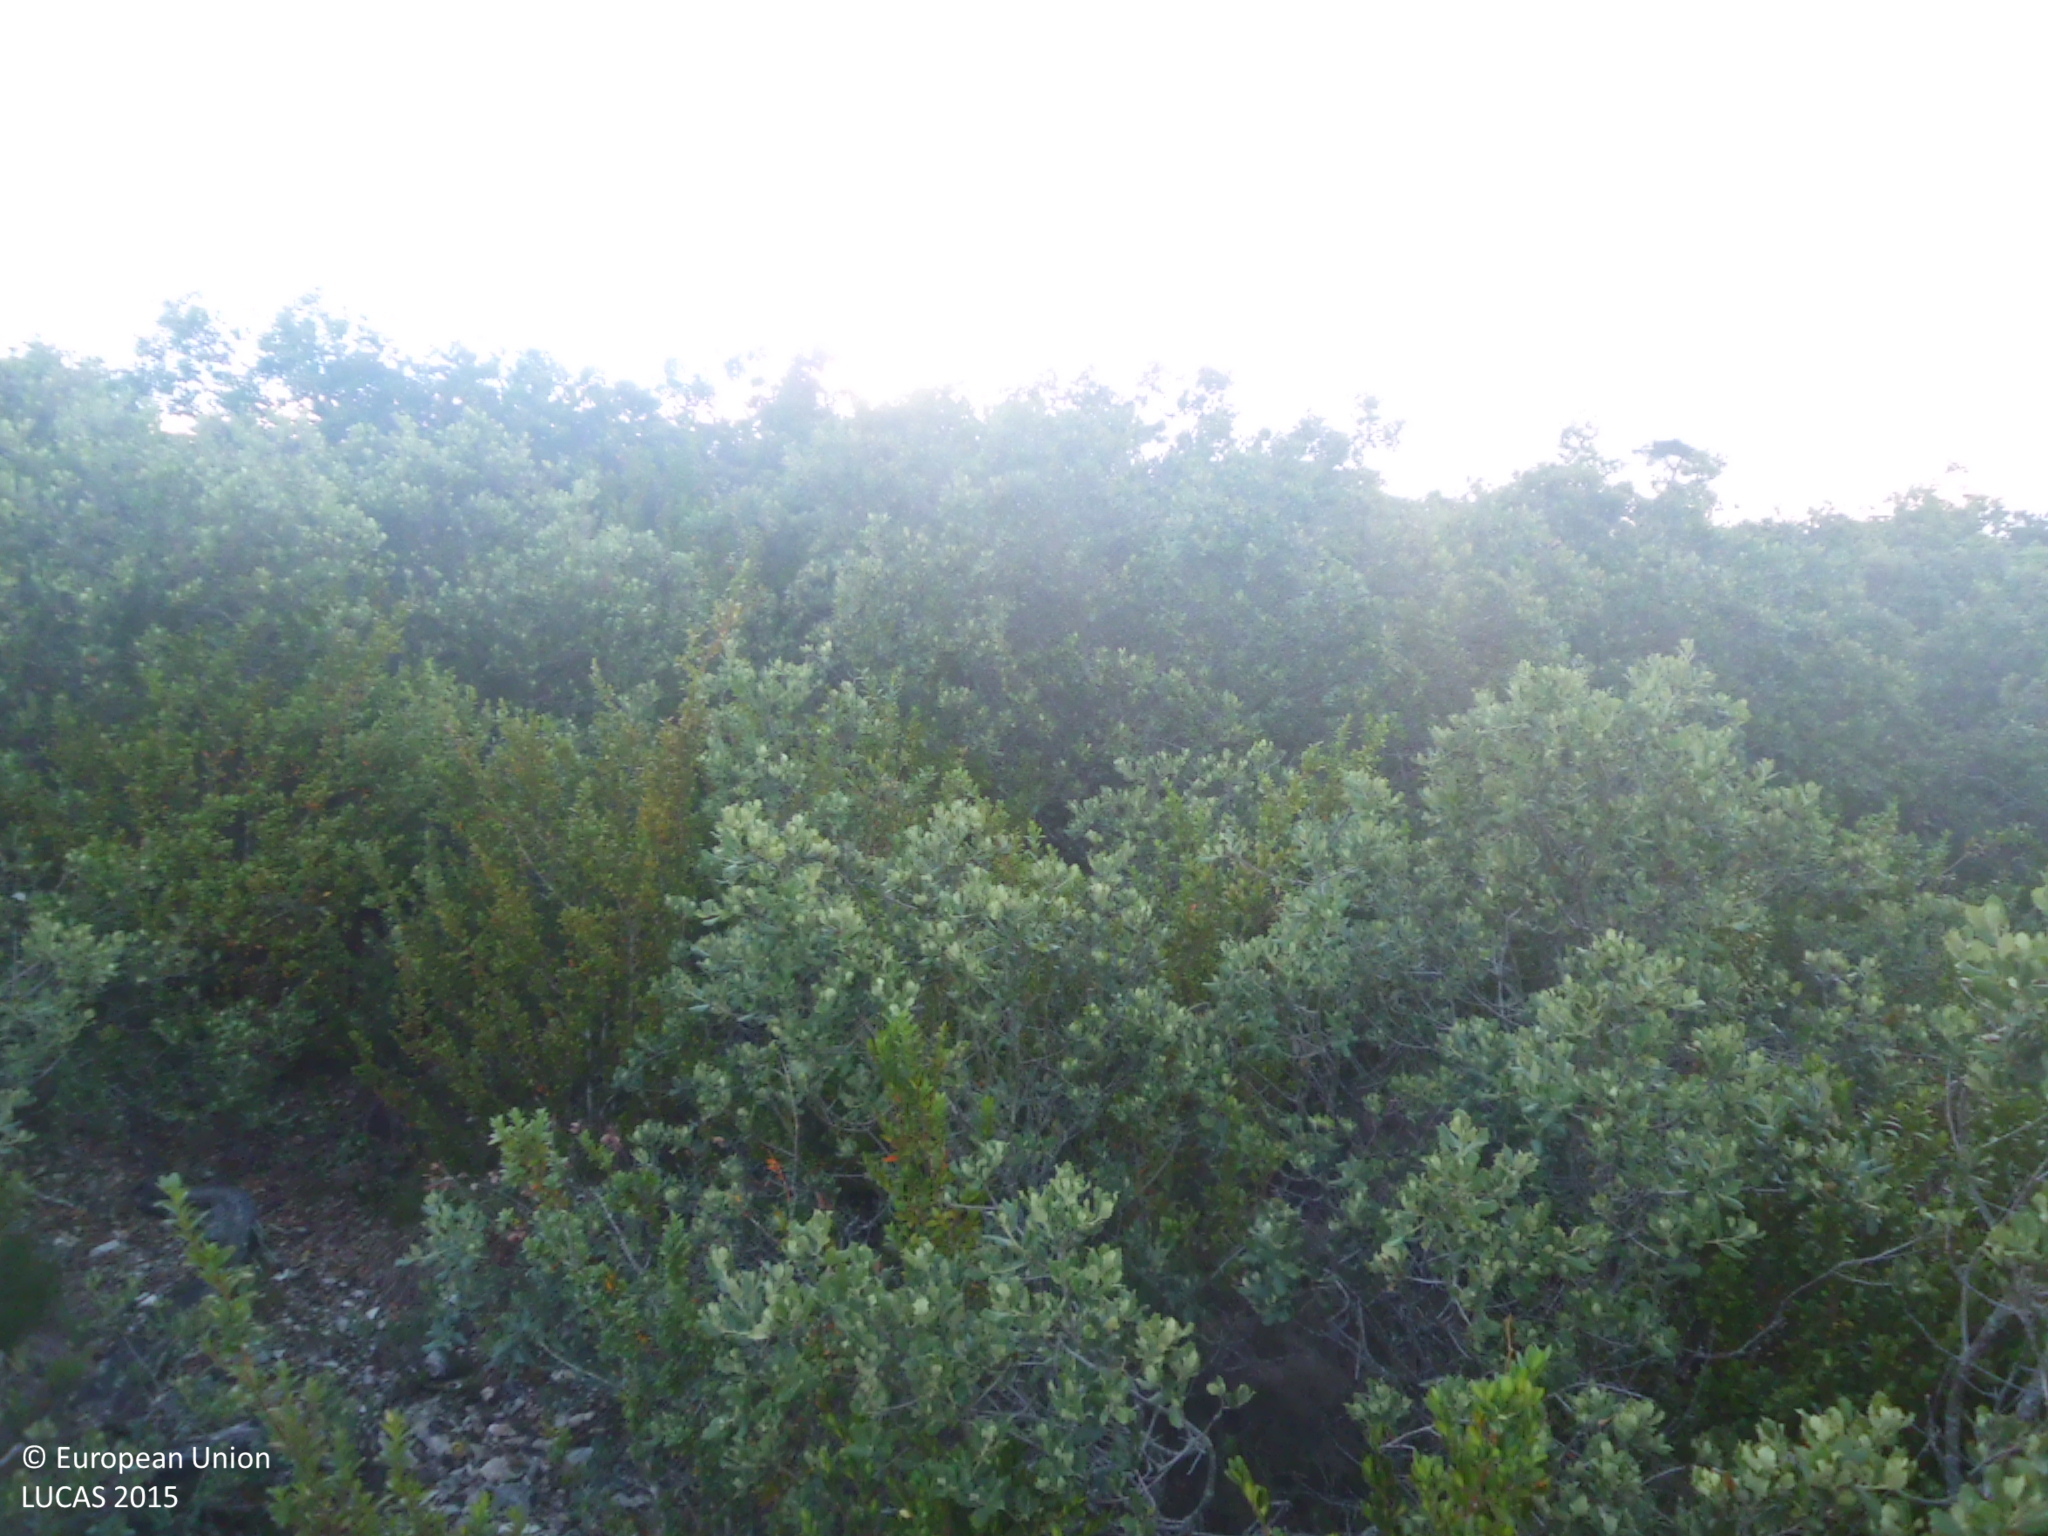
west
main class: Woodland
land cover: Broadleaved woodland
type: thermophilous deciduous forest
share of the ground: 25 - 50 %
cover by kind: broadleaved forest trees 45 %, shrubs 45 %, herbaceous plants 10 %
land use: Semi-natural and natural areas not in use
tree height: < 5 m
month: June
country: ES
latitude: 42.7831
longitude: -3.3969
